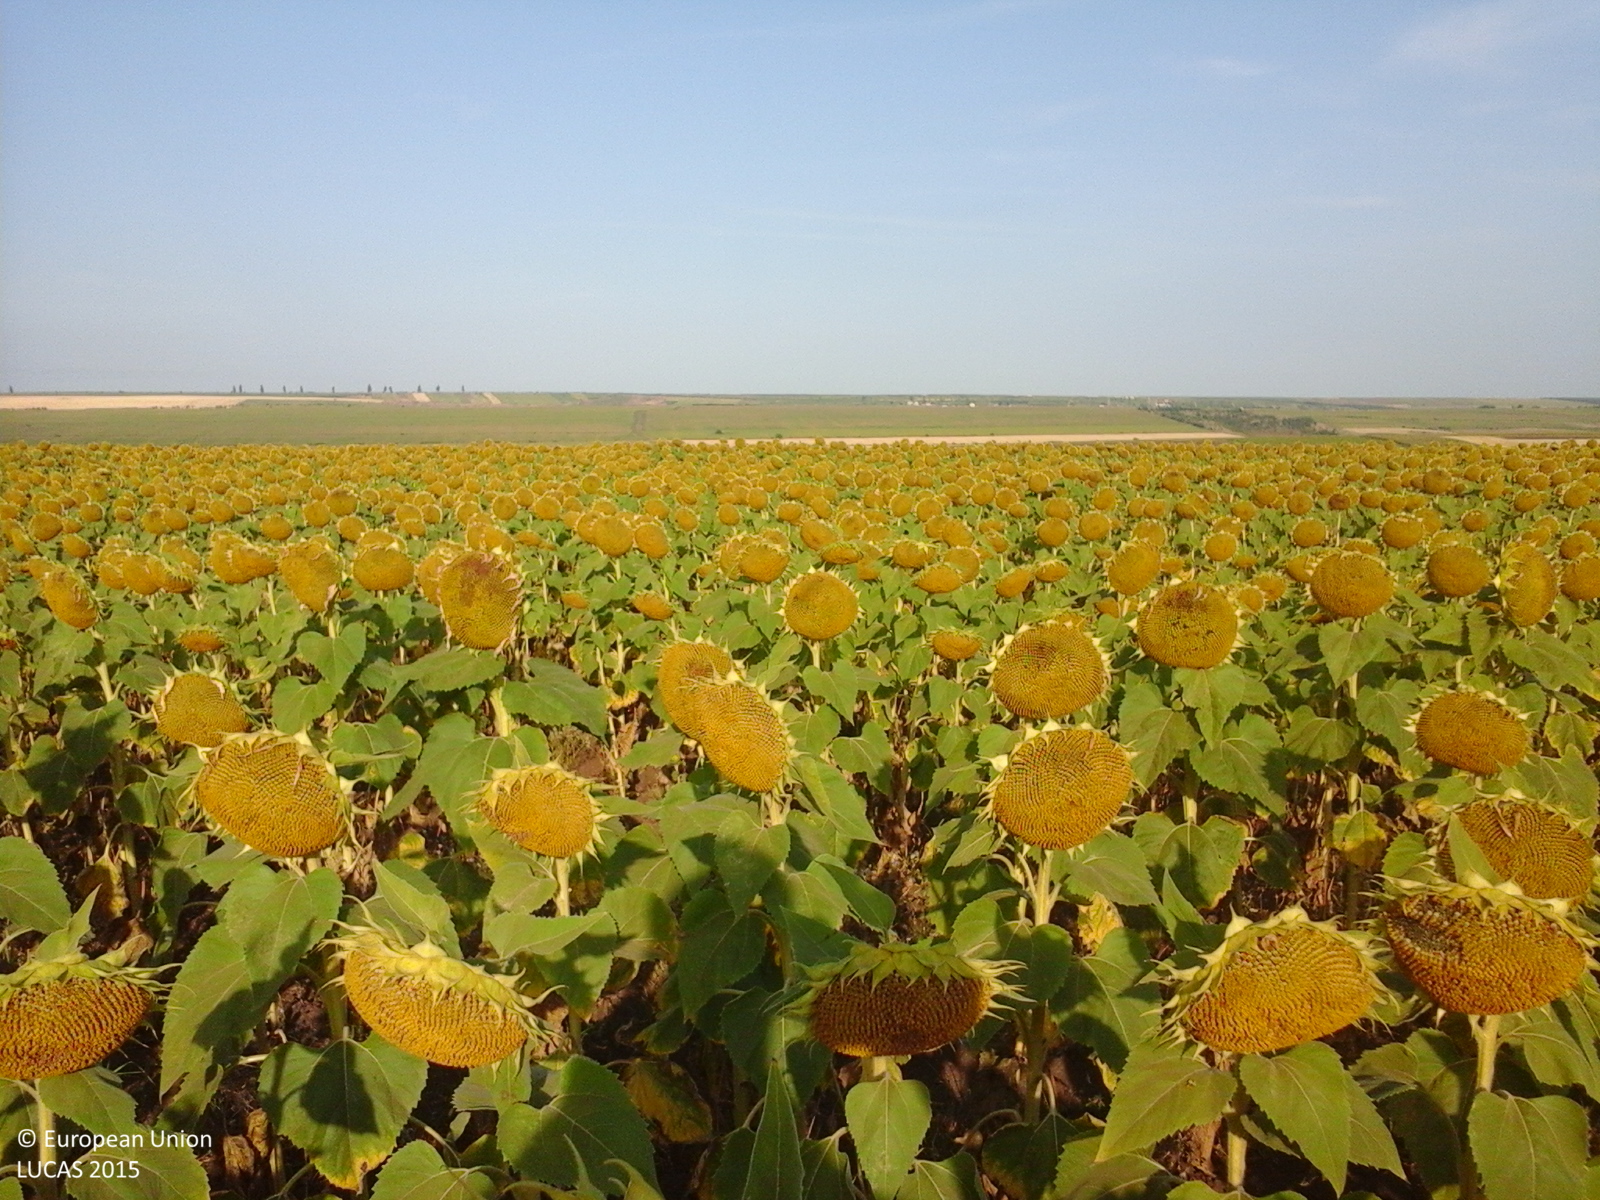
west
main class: Cropland
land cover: Sunflower
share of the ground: > 75 %
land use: Agriculture (excluding fallow land and kitchen gardens)
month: July
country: RO
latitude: 45.9654
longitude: 27.8077
